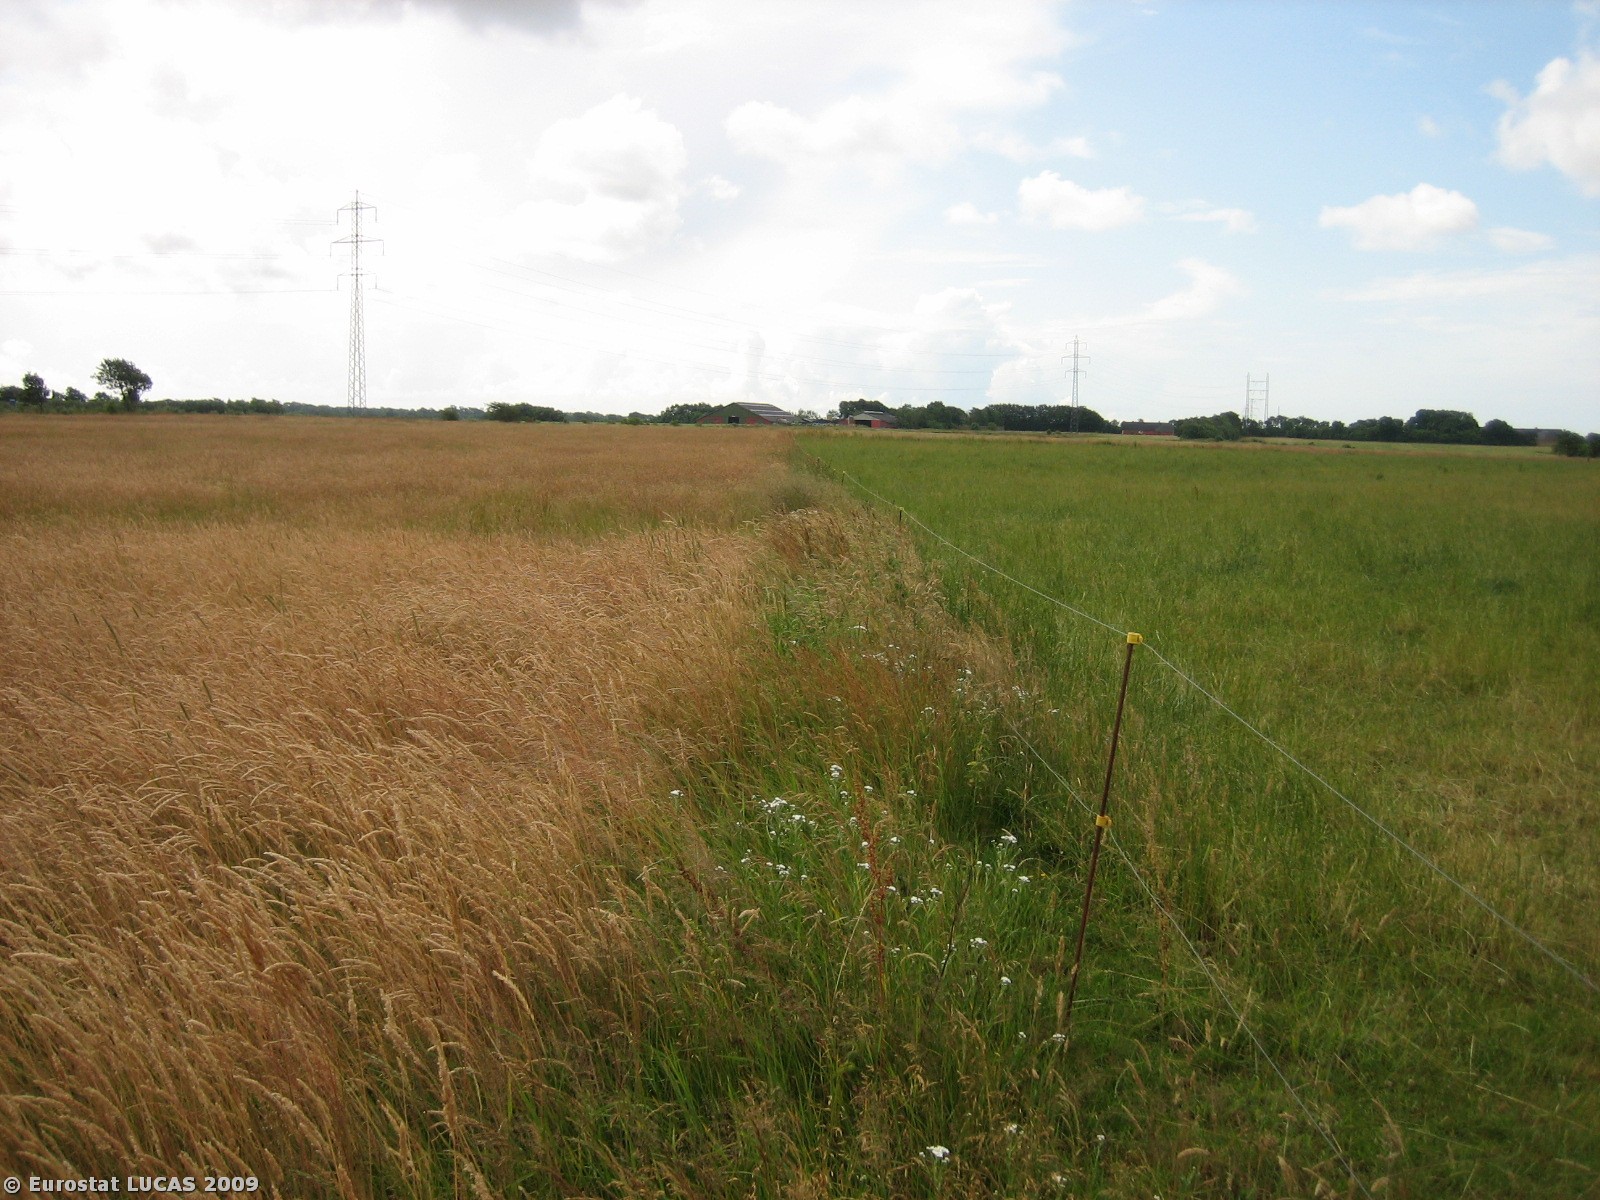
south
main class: Grassland
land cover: Grassland without tree/shrub cover
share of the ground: > 75 %
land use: Agriculture (excluding fallow land and kitchen gardens)
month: July
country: DK
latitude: 55.5680
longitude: 8.5265
